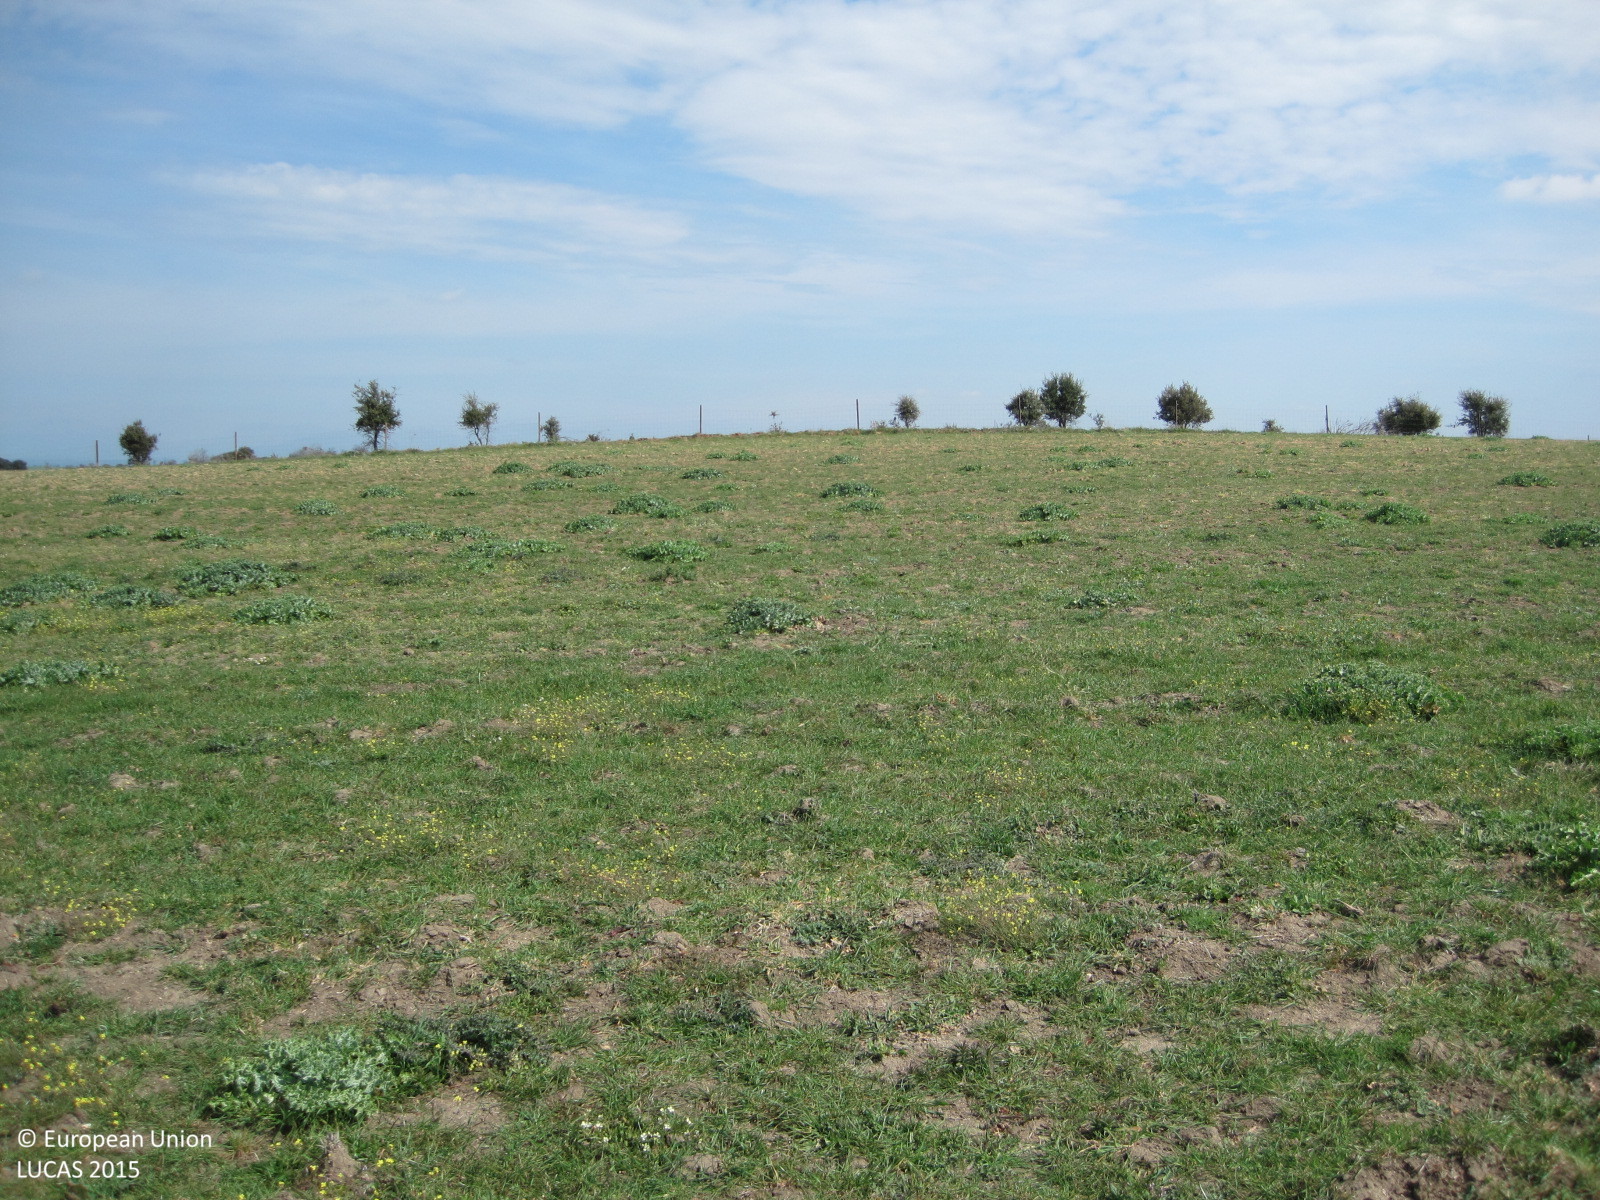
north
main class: Grassland
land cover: Grassland without tree/shrub cover
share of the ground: > 75 %
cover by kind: herbaceous plants 90 %, unconsolidated bare surface 10 %
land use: Agriculture (excluding fallow land and kitchen gardens)
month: April
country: ES
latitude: 39.8527
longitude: -5.0456
